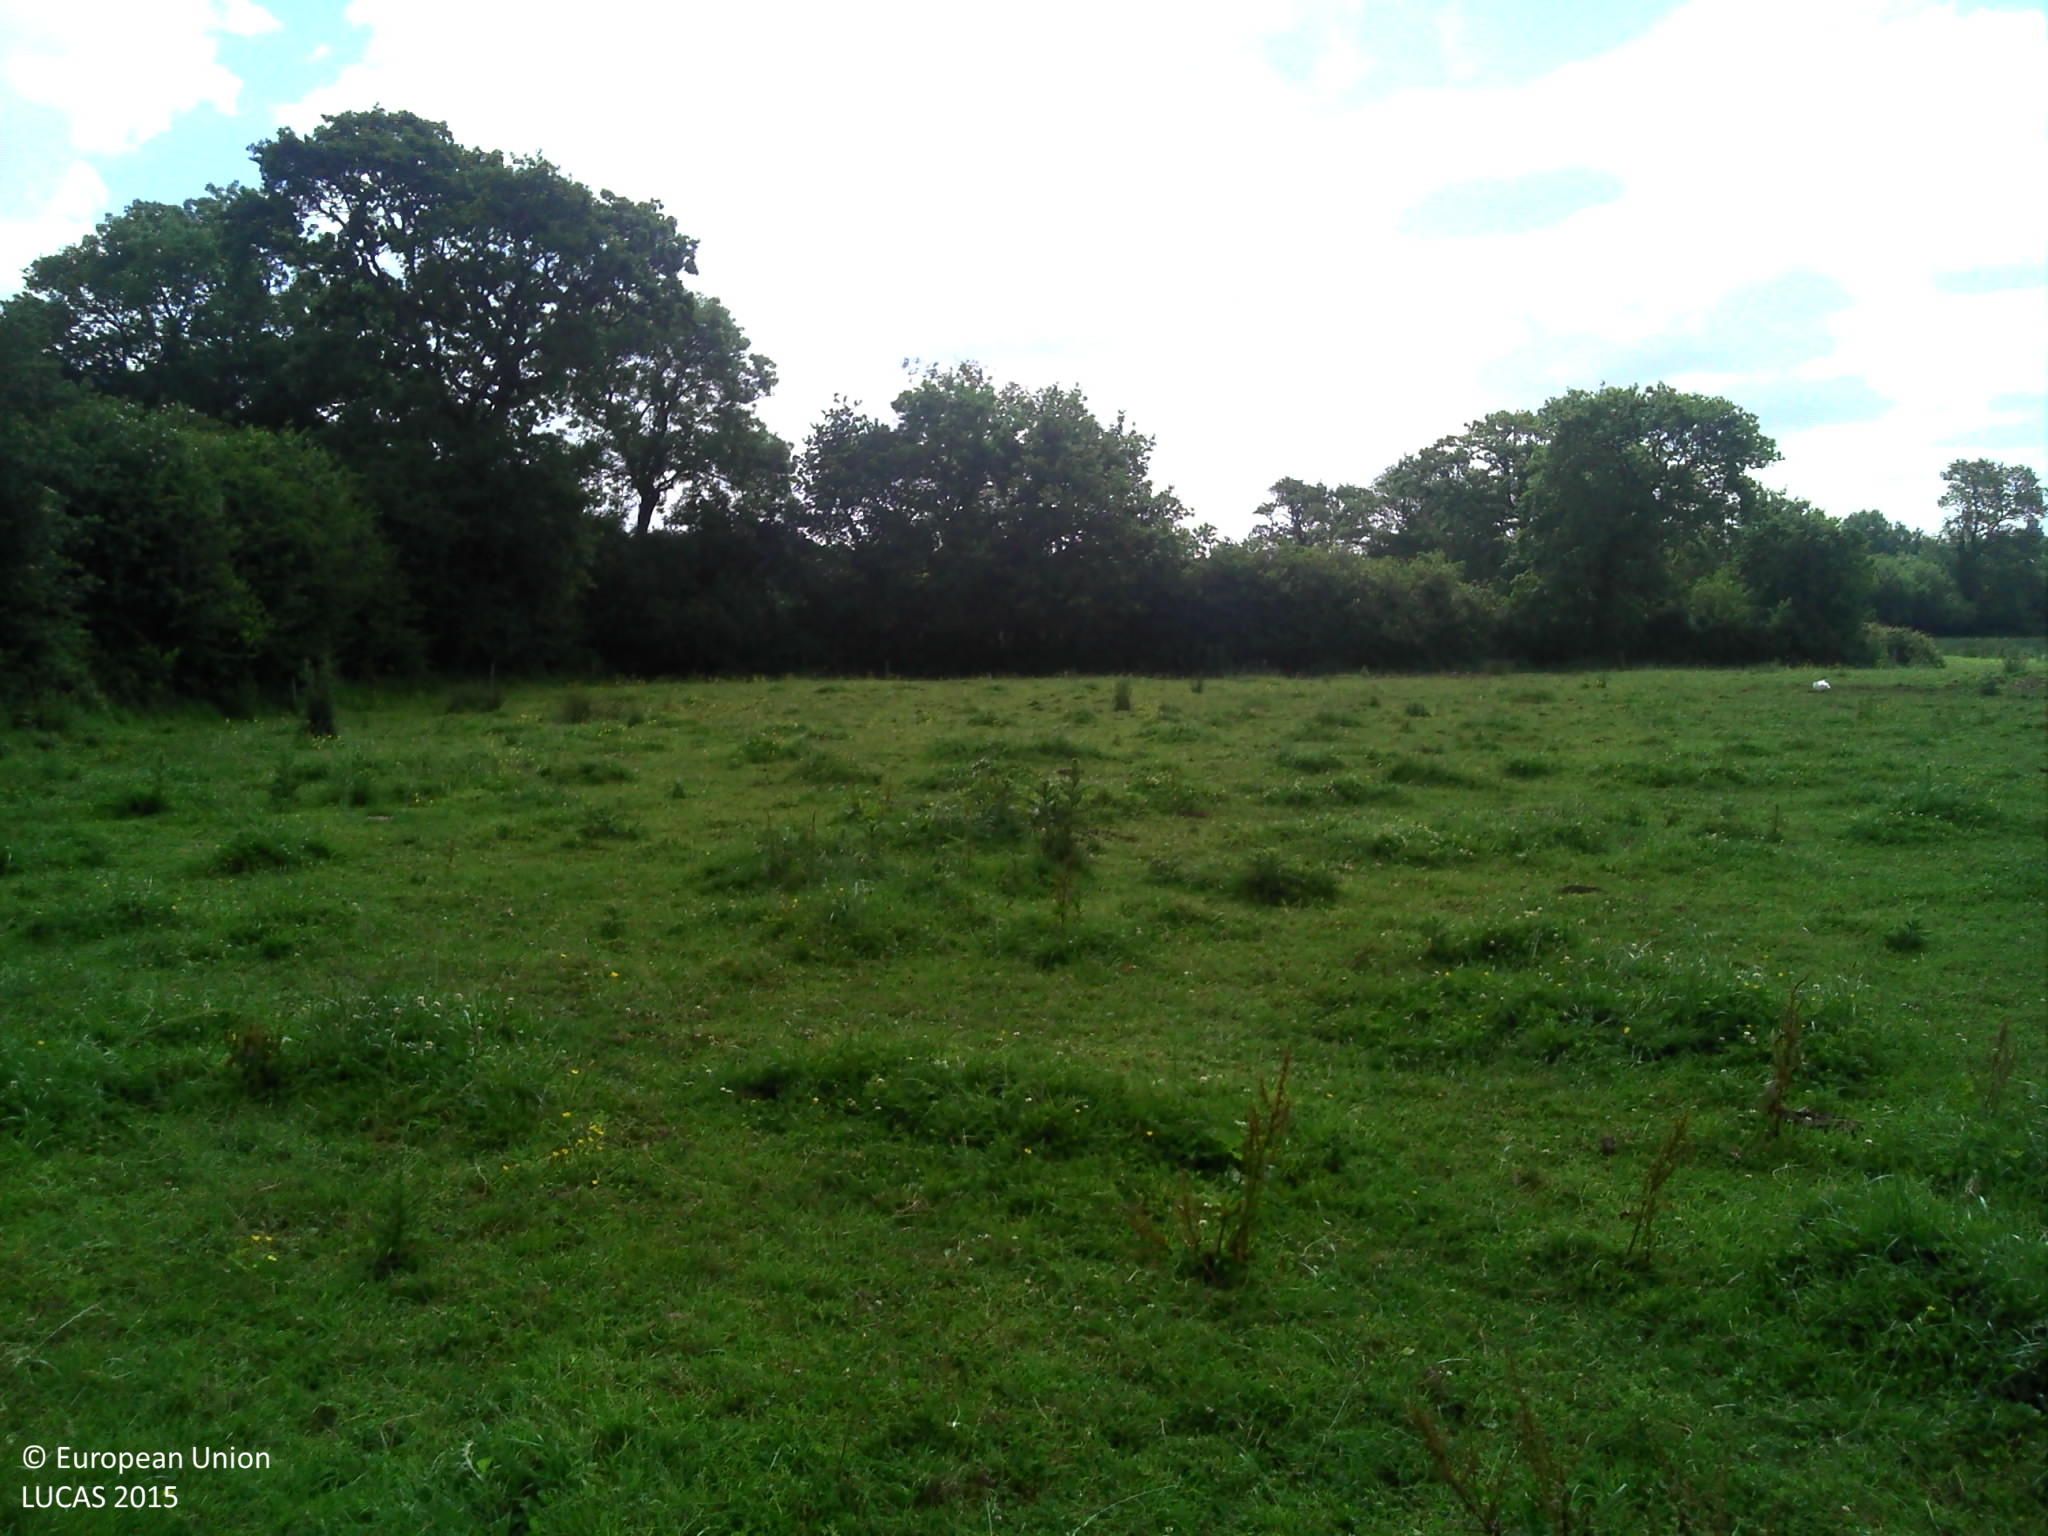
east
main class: Grassland
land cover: Grassland without tree/shrub cover
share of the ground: > 75 %
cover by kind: herbaceous plants 100 %
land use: Agriculture (excluding fallow land and kitchen gardens)
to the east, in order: Grassland without tree/shrub cover; Fences; Broadleaved woodland; Fences; Grassland without tree/shrub cover
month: June
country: FR
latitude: 49.2528
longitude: -1.5211
